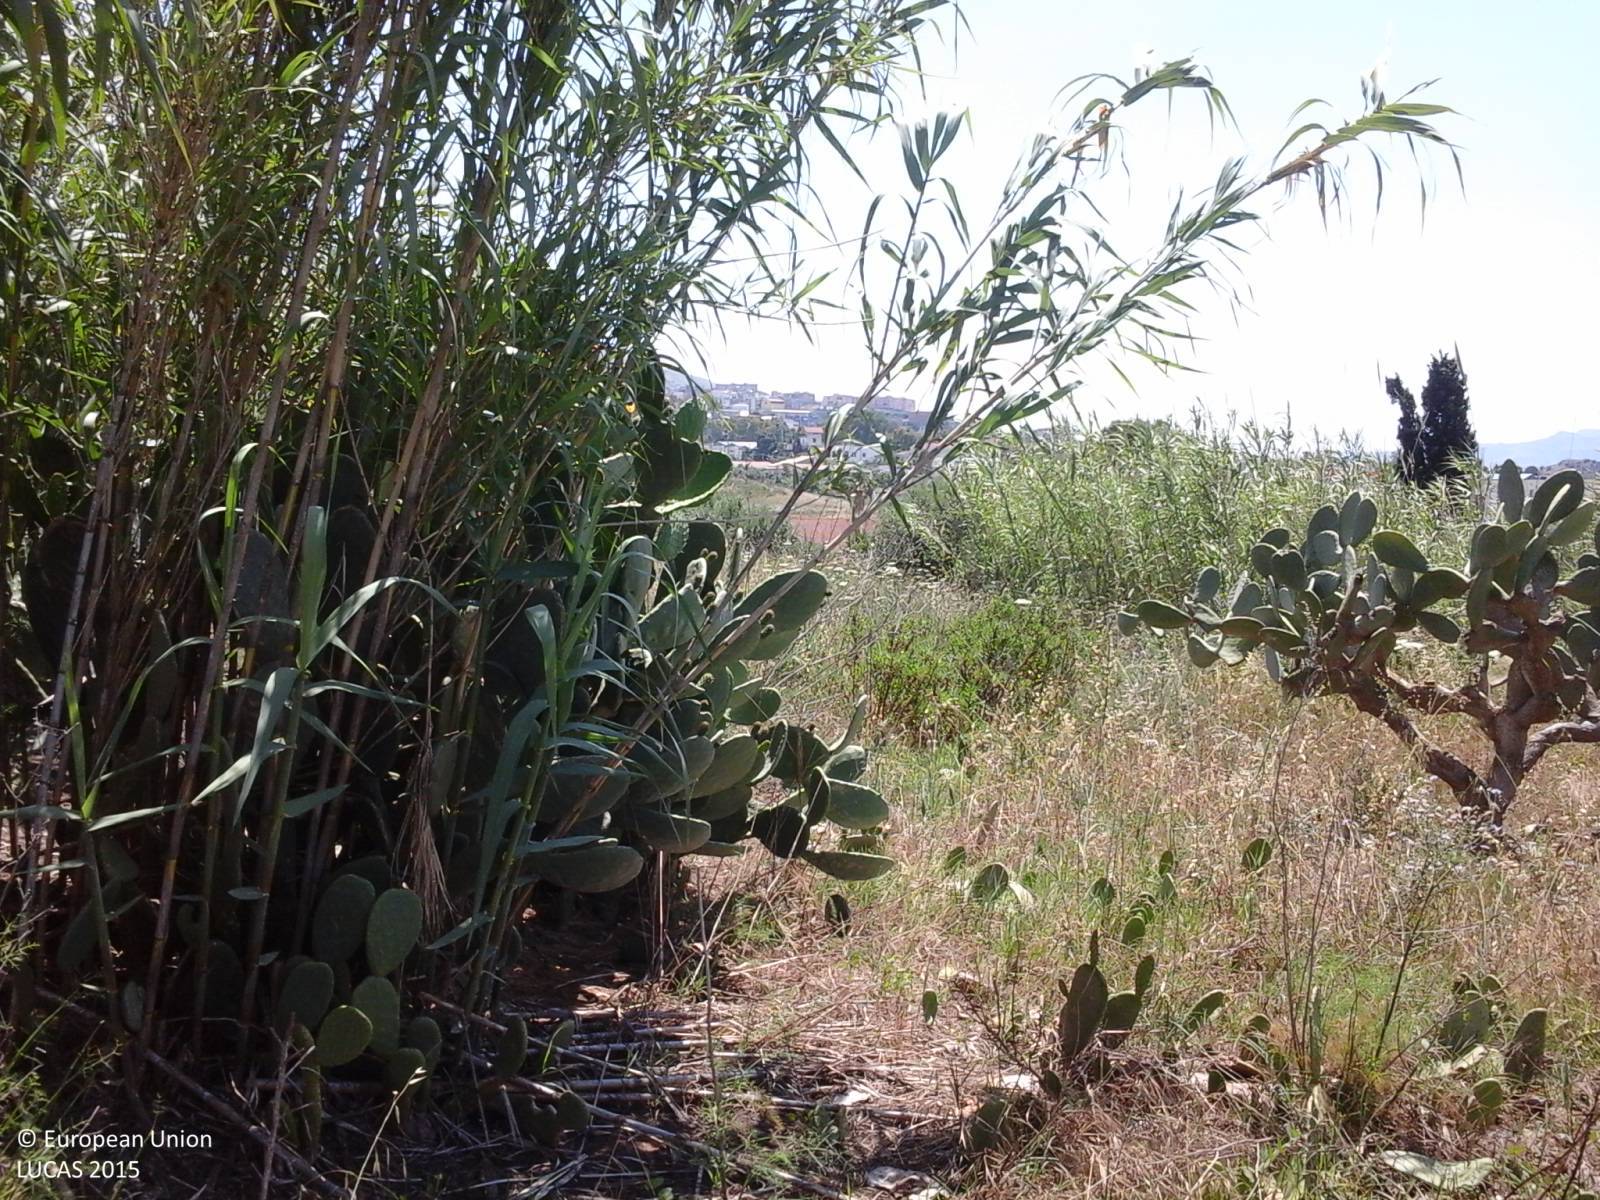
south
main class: Grassland
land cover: Grassland without tree/shrub cover
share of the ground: > 75 %
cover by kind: herbaceous plants 100 %
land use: Abandoned areas
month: June
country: IT
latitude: 37.9924
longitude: 12.9507
